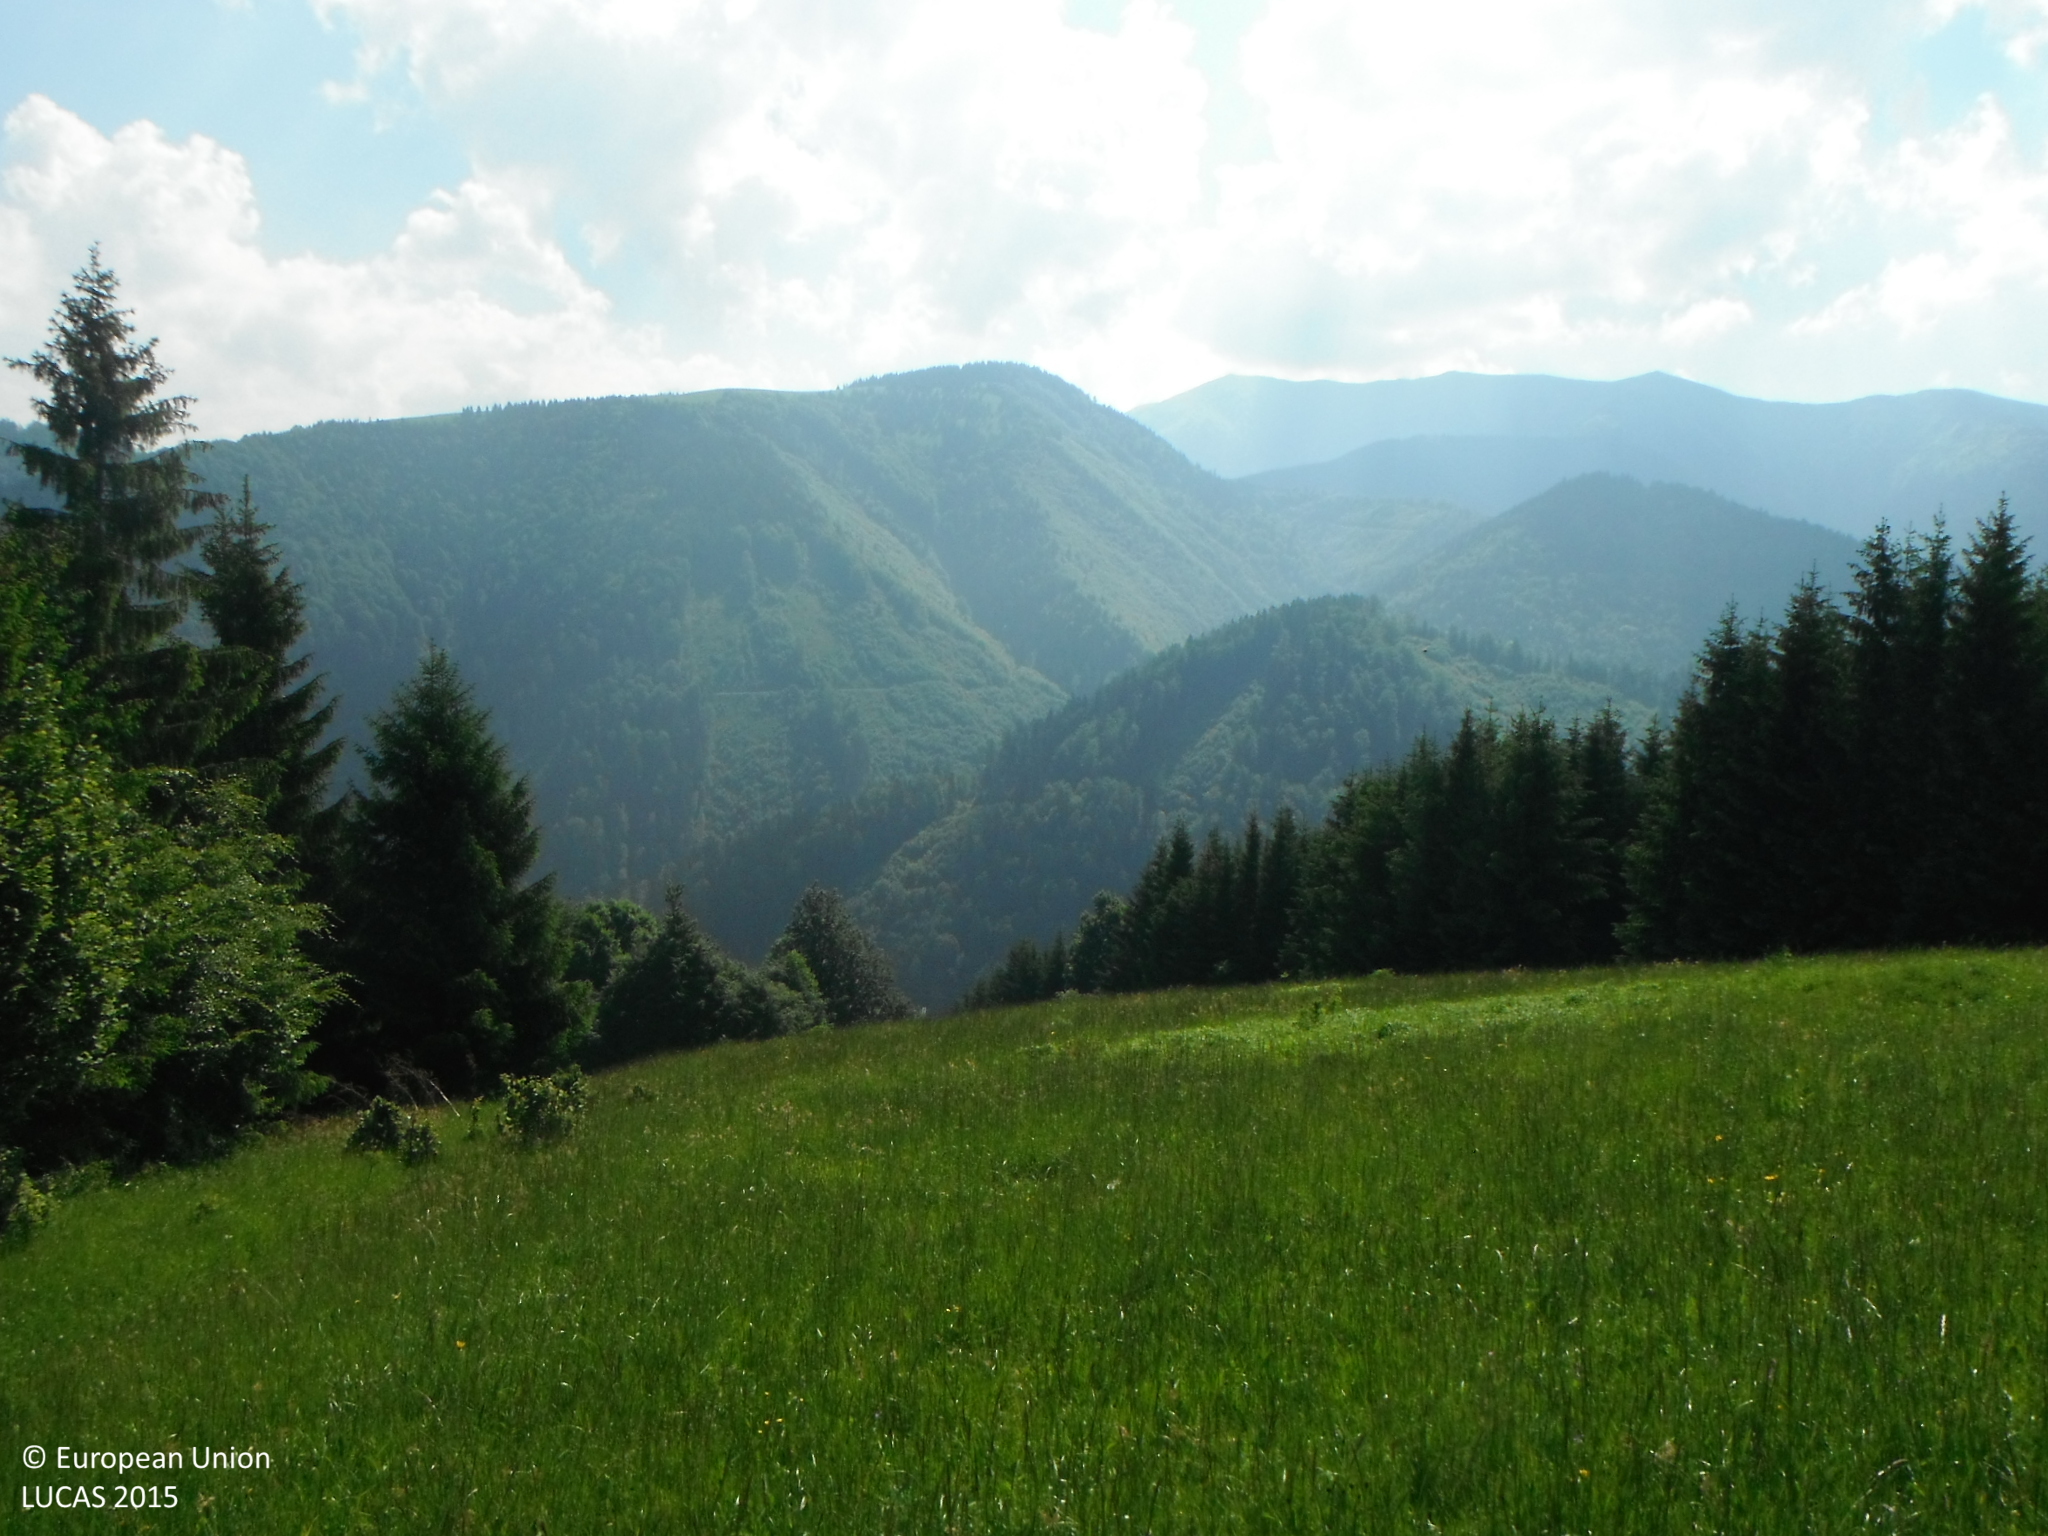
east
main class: Grassland
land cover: Grassland without tree/shrub cover
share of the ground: > 75 %
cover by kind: herbaceous plants 100 %
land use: Agriculture (excluding fallow land and kitchen gardens)
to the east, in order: Grassland without tree/shrub cover; Spontaneously vegetated surfaces; Grassland with sparse tree/shrub cover; Spruce dominated coniferous woodland
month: June
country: SK
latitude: 48.9016
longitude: 19.2592
